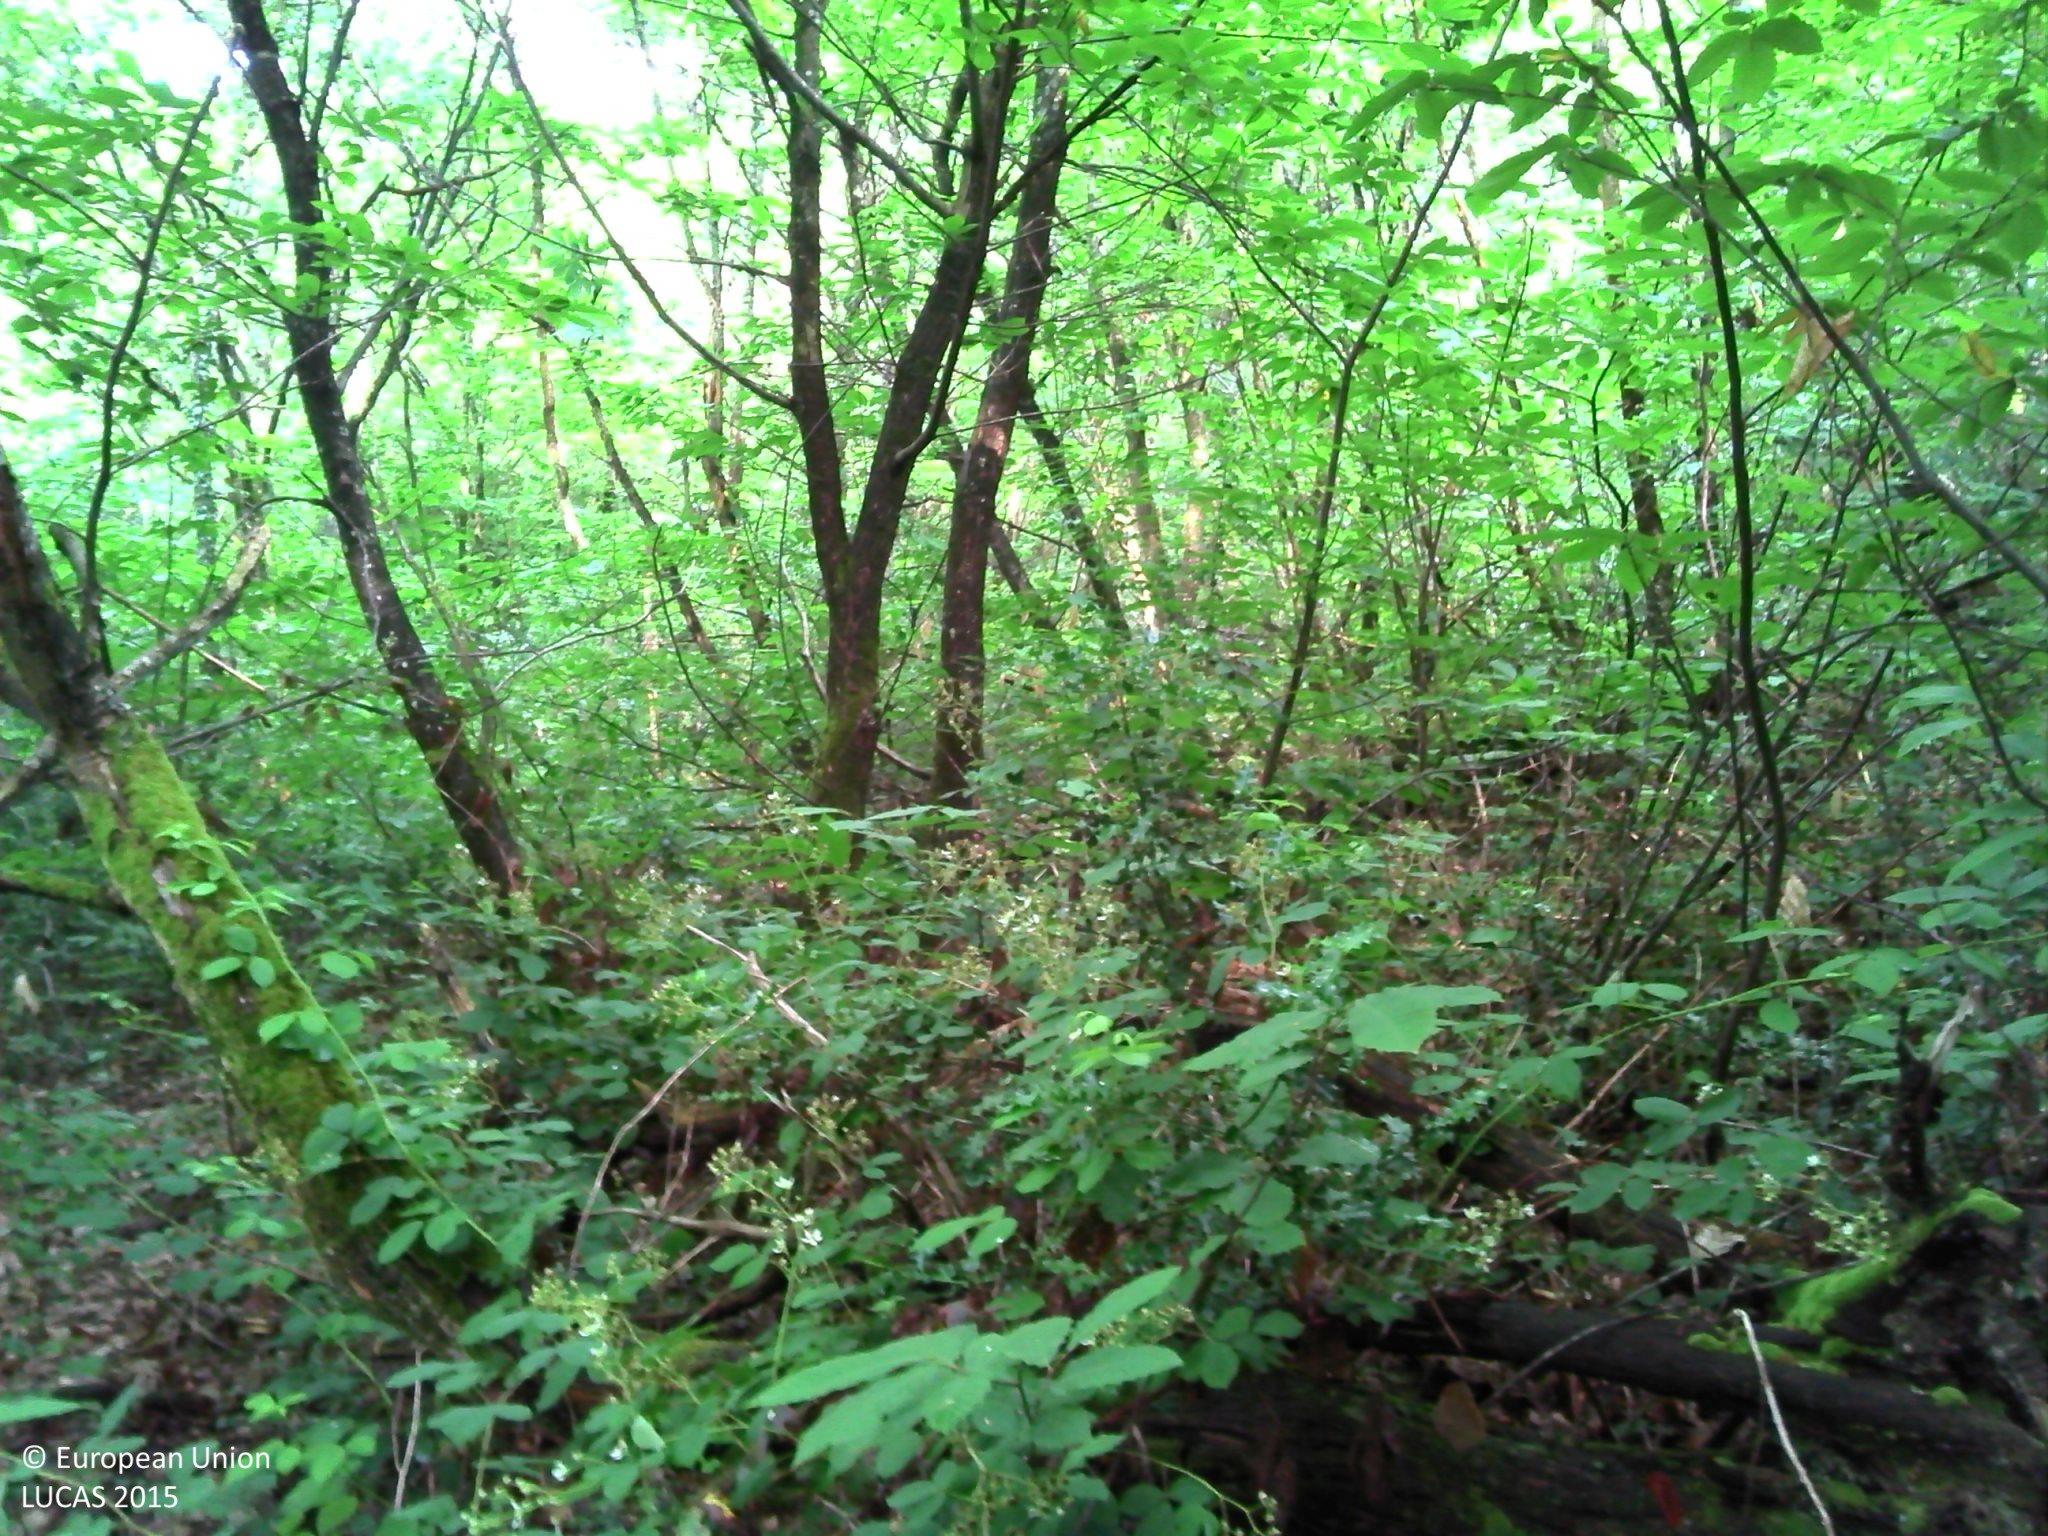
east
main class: Woodland
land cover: Broadleaved woodland
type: acidophilous oak and oak-birch forest
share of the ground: > 75 %
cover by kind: broadleaved forest trees 90 %, shrubs 5 %, herbaceous plants 5 %
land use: Forestry
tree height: > 5 m
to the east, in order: Broadleaved woodland; Grass margins; Paved roads, cycling and walking lanes; Grass margins; Electric lines; Broadleaved woodland
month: June
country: FR
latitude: 43.6457
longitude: -0.2109
